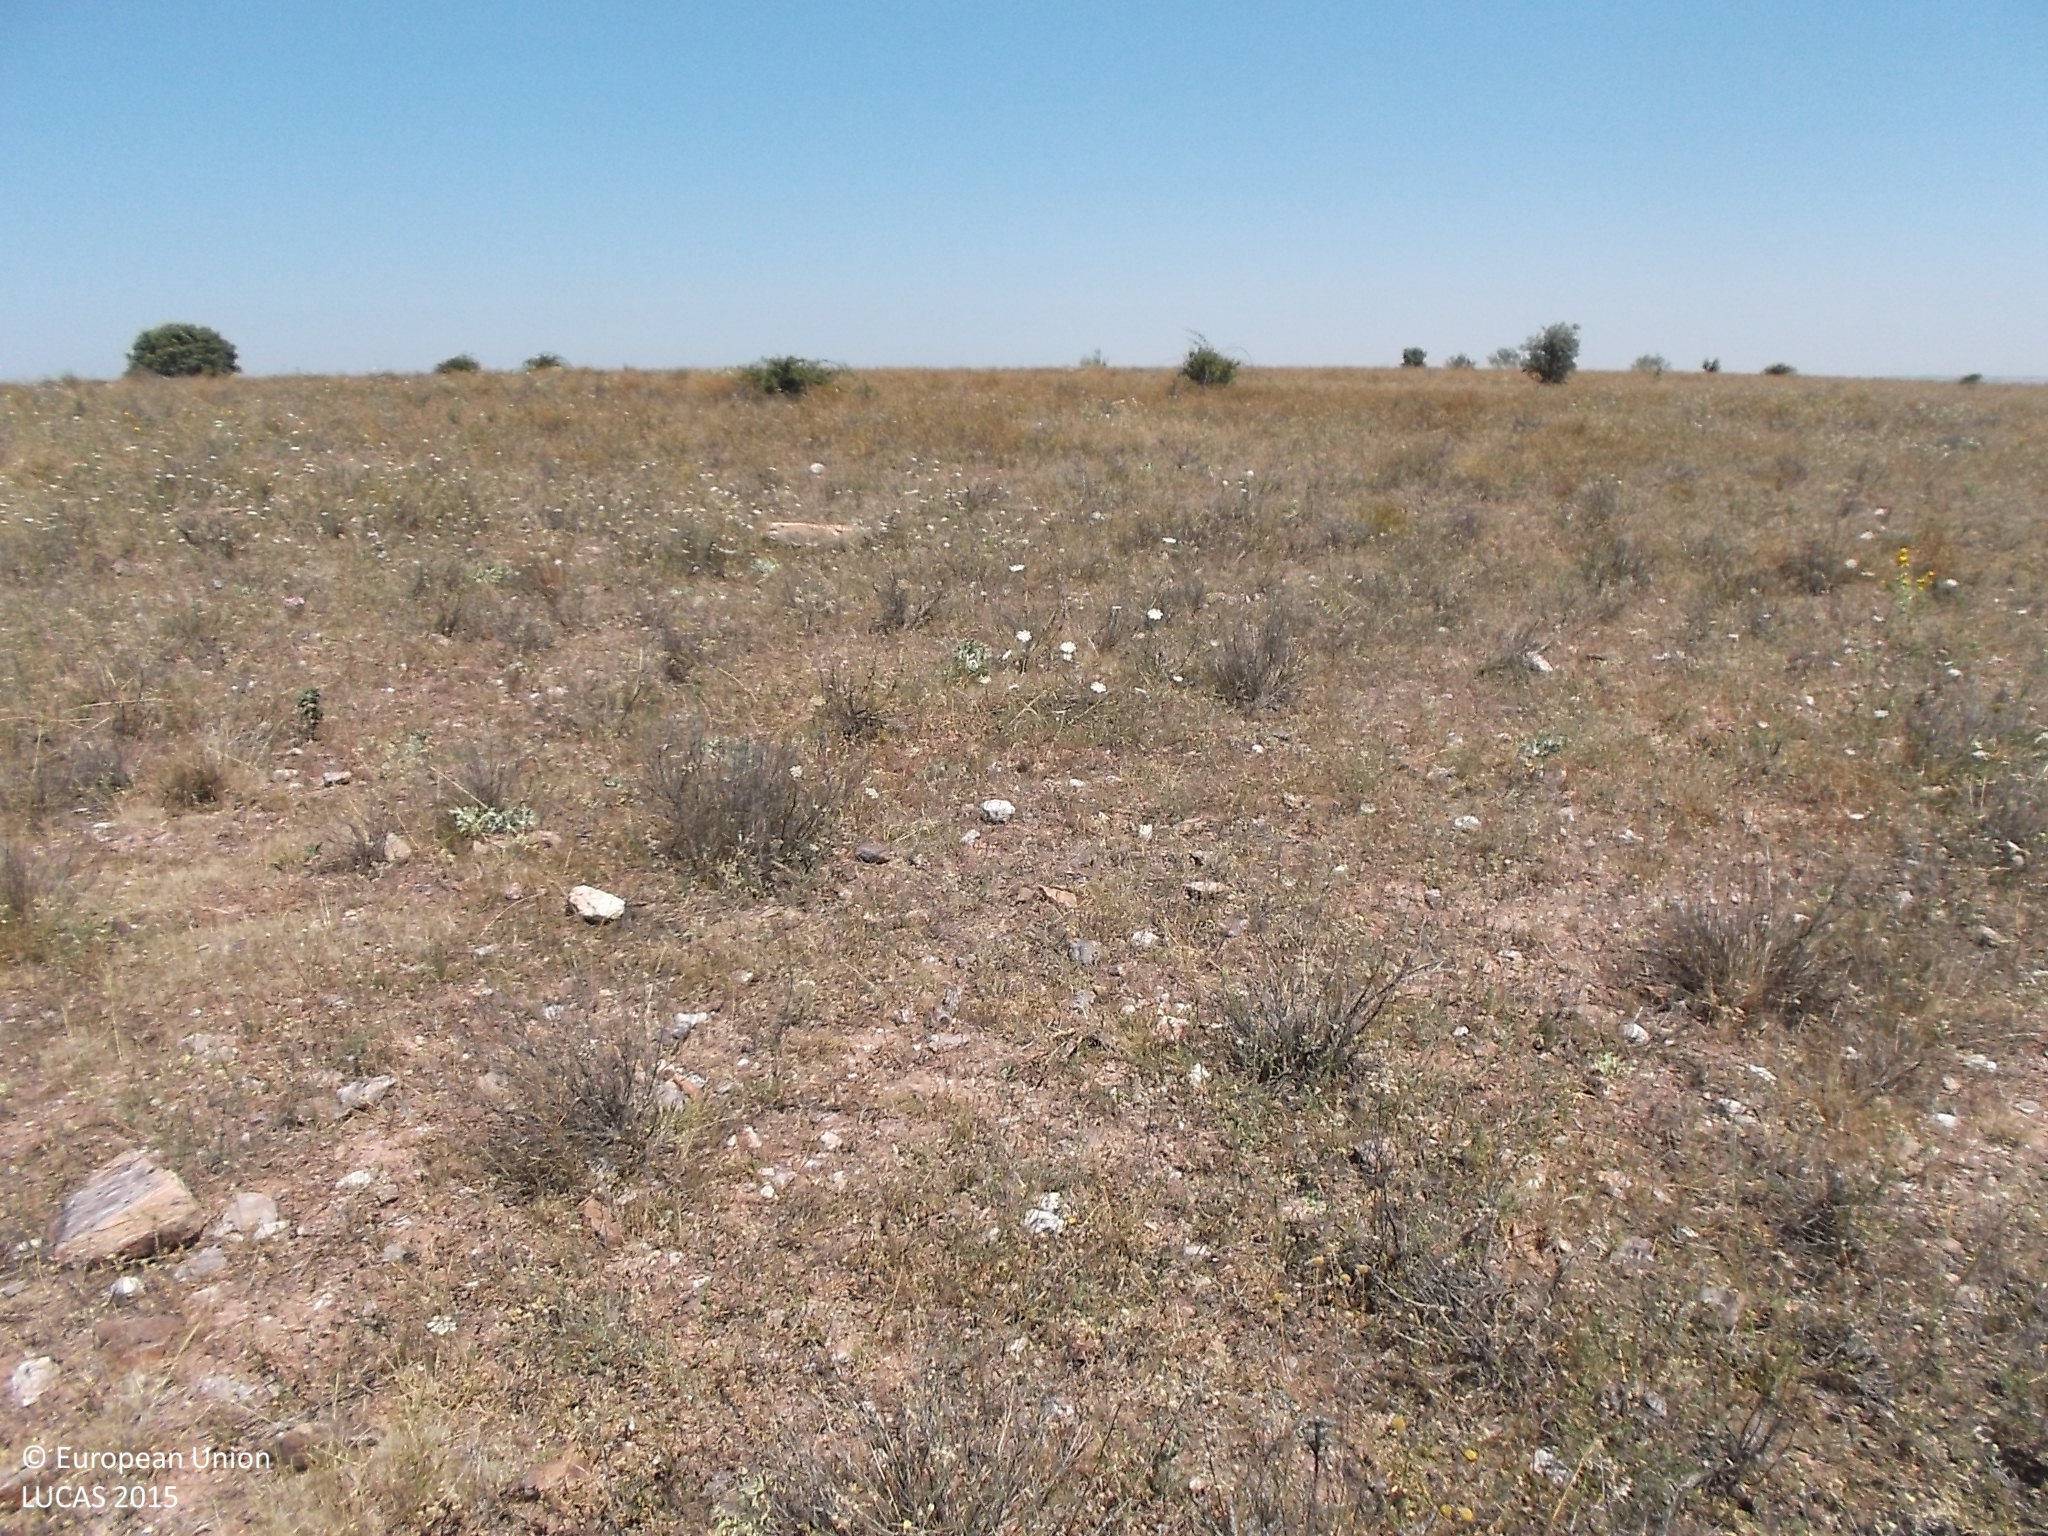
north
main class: Shrubland
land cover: Shrubland without tree cover
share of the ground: > 75 %
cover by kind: shrubs 100 %
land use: Agriculture (excluding fallow land and kitchen gardens)
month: July
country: ES
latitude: 41.4551
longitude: -5.8297
